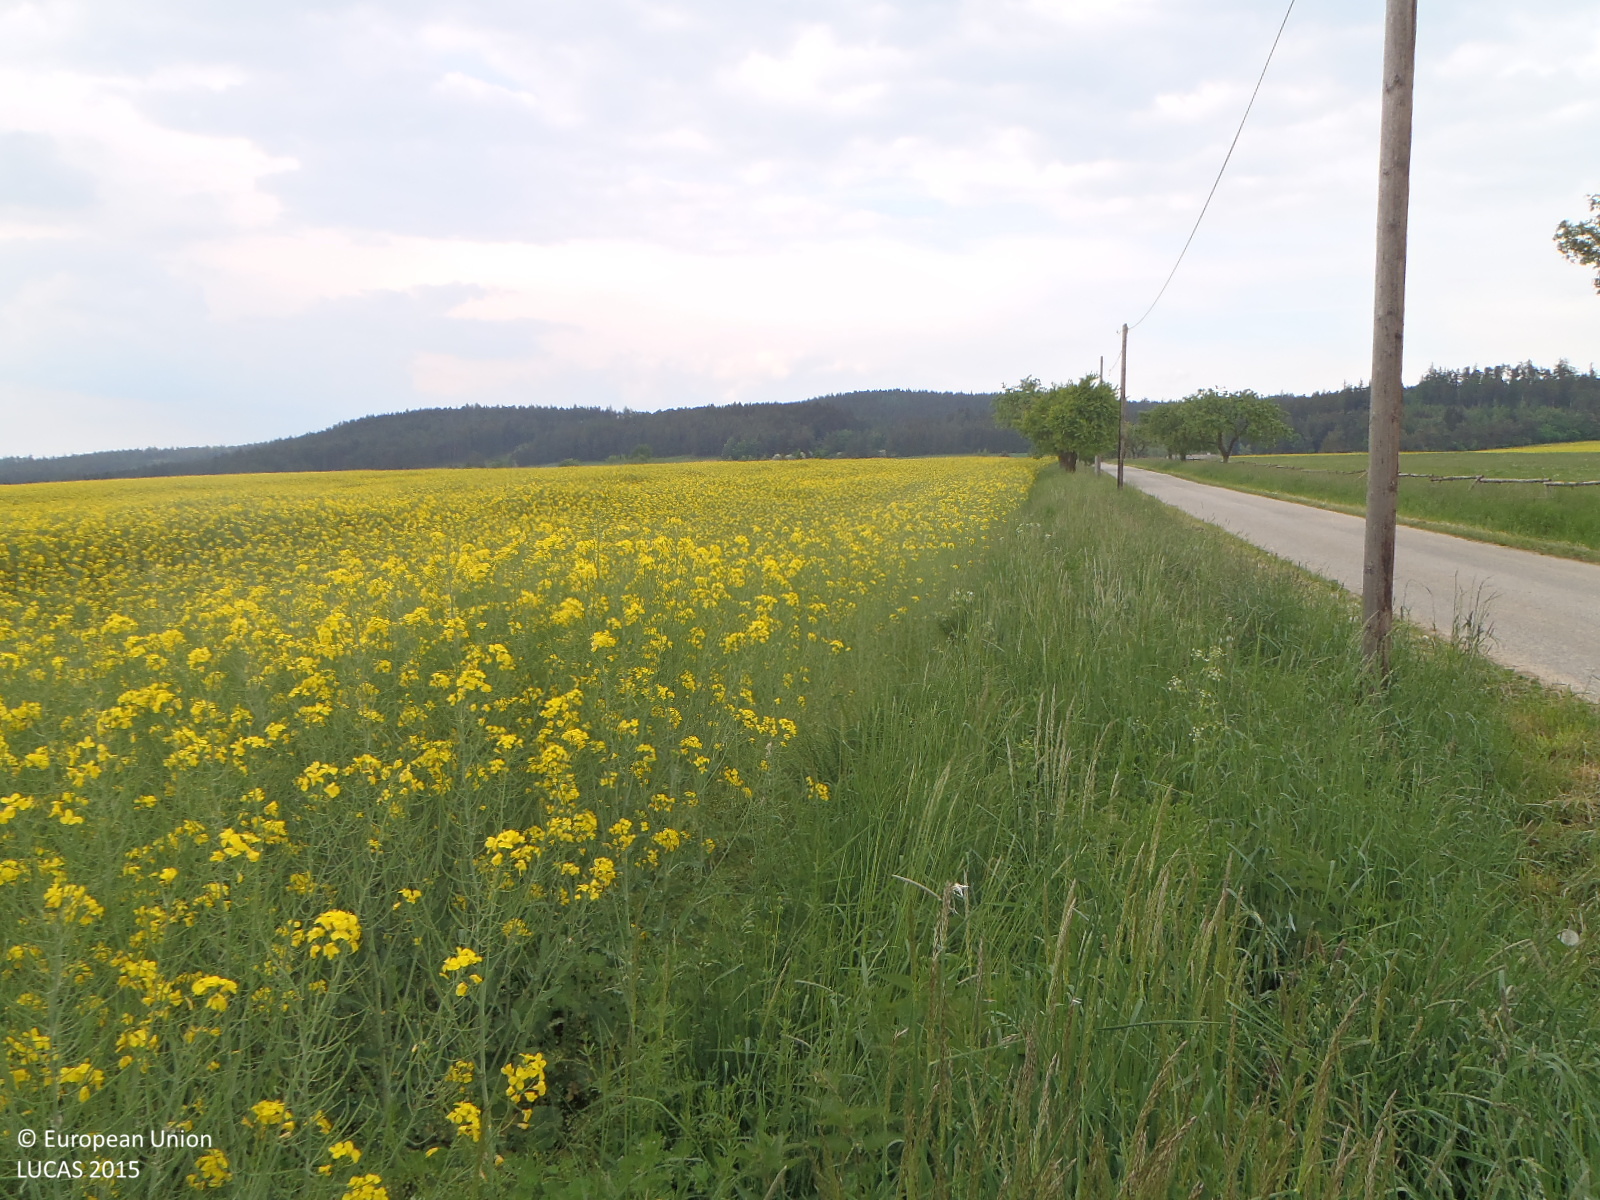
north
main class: Grassland
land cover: Grassland without tree/shrub cover
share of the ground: > 75 %
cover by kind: herbaceous plants 100 %
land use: Semi-natural and natural areas not in use
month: May
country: CZ
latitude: 48.9708
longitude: 15.4813
